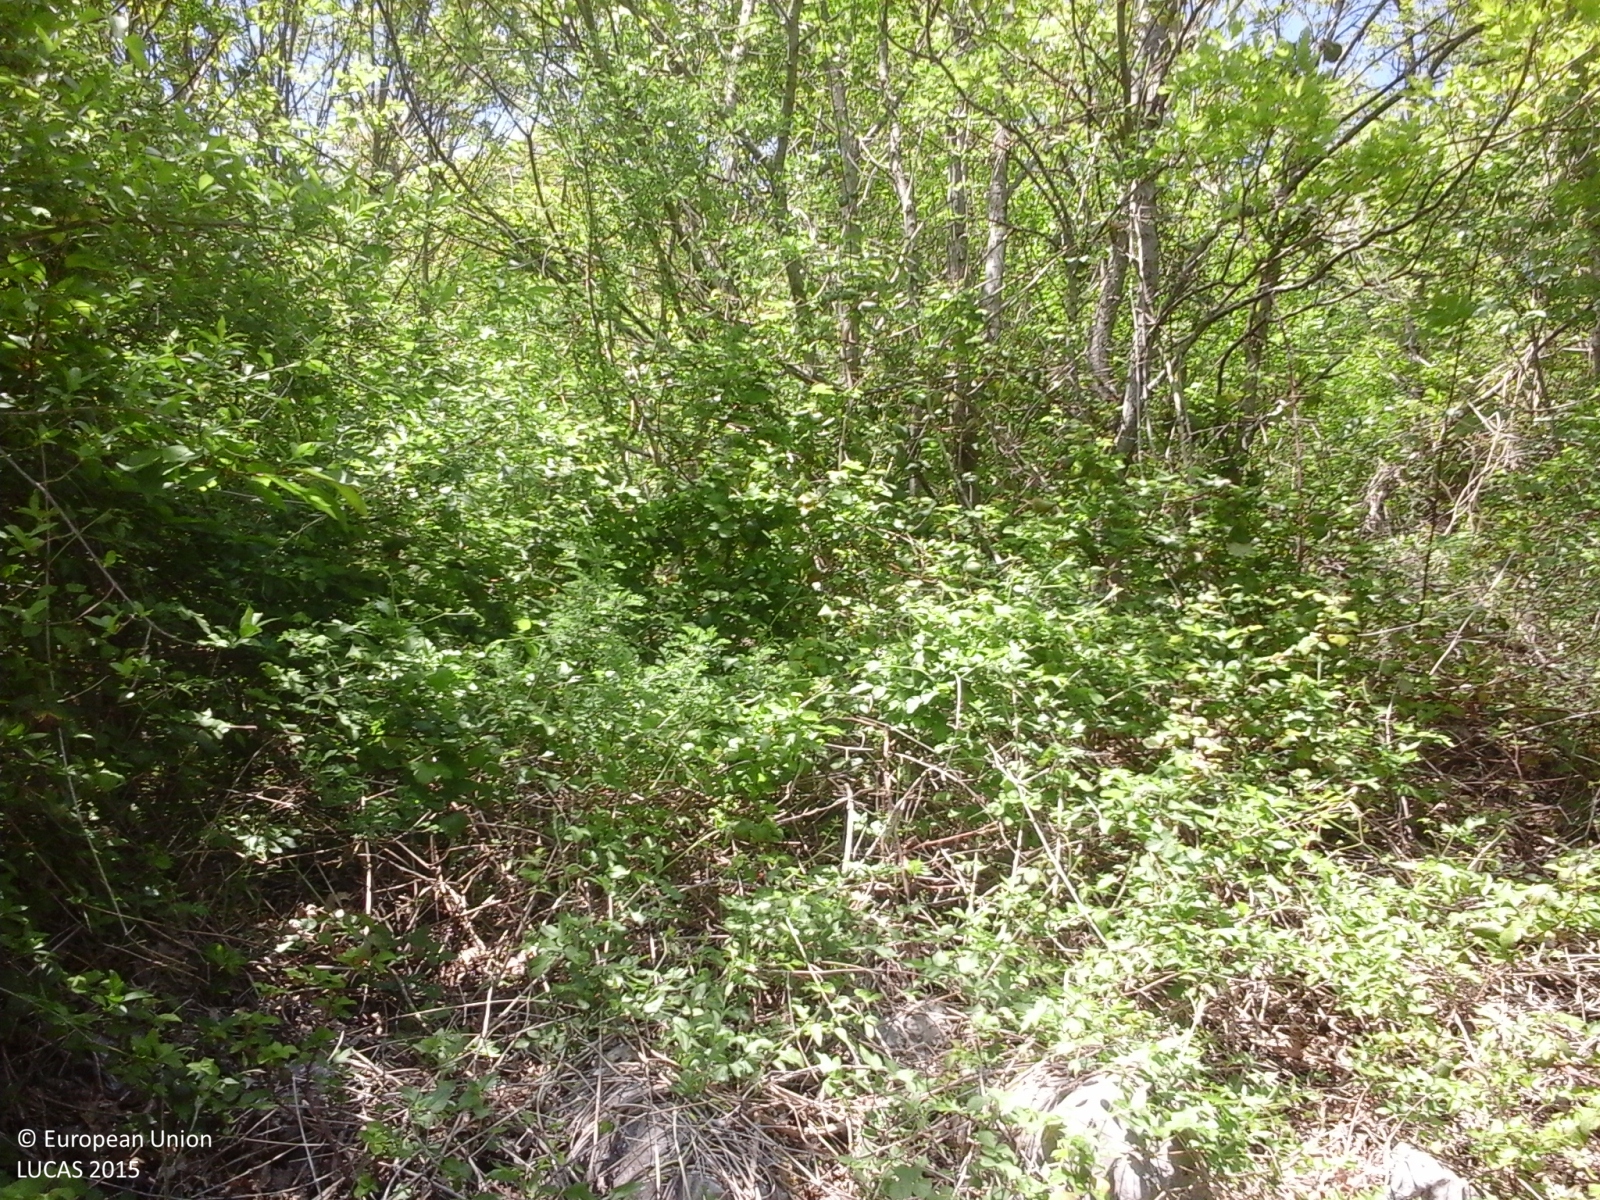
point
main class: Woodland
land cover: Broadleaved woodland
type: thermophilous deciduous forest
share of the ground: > 75 %
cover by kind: broadleaved forest trees 100 %
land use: Forestry
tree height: > 5 m
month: May
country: IT
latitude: 41.3164
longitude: 14.6537
